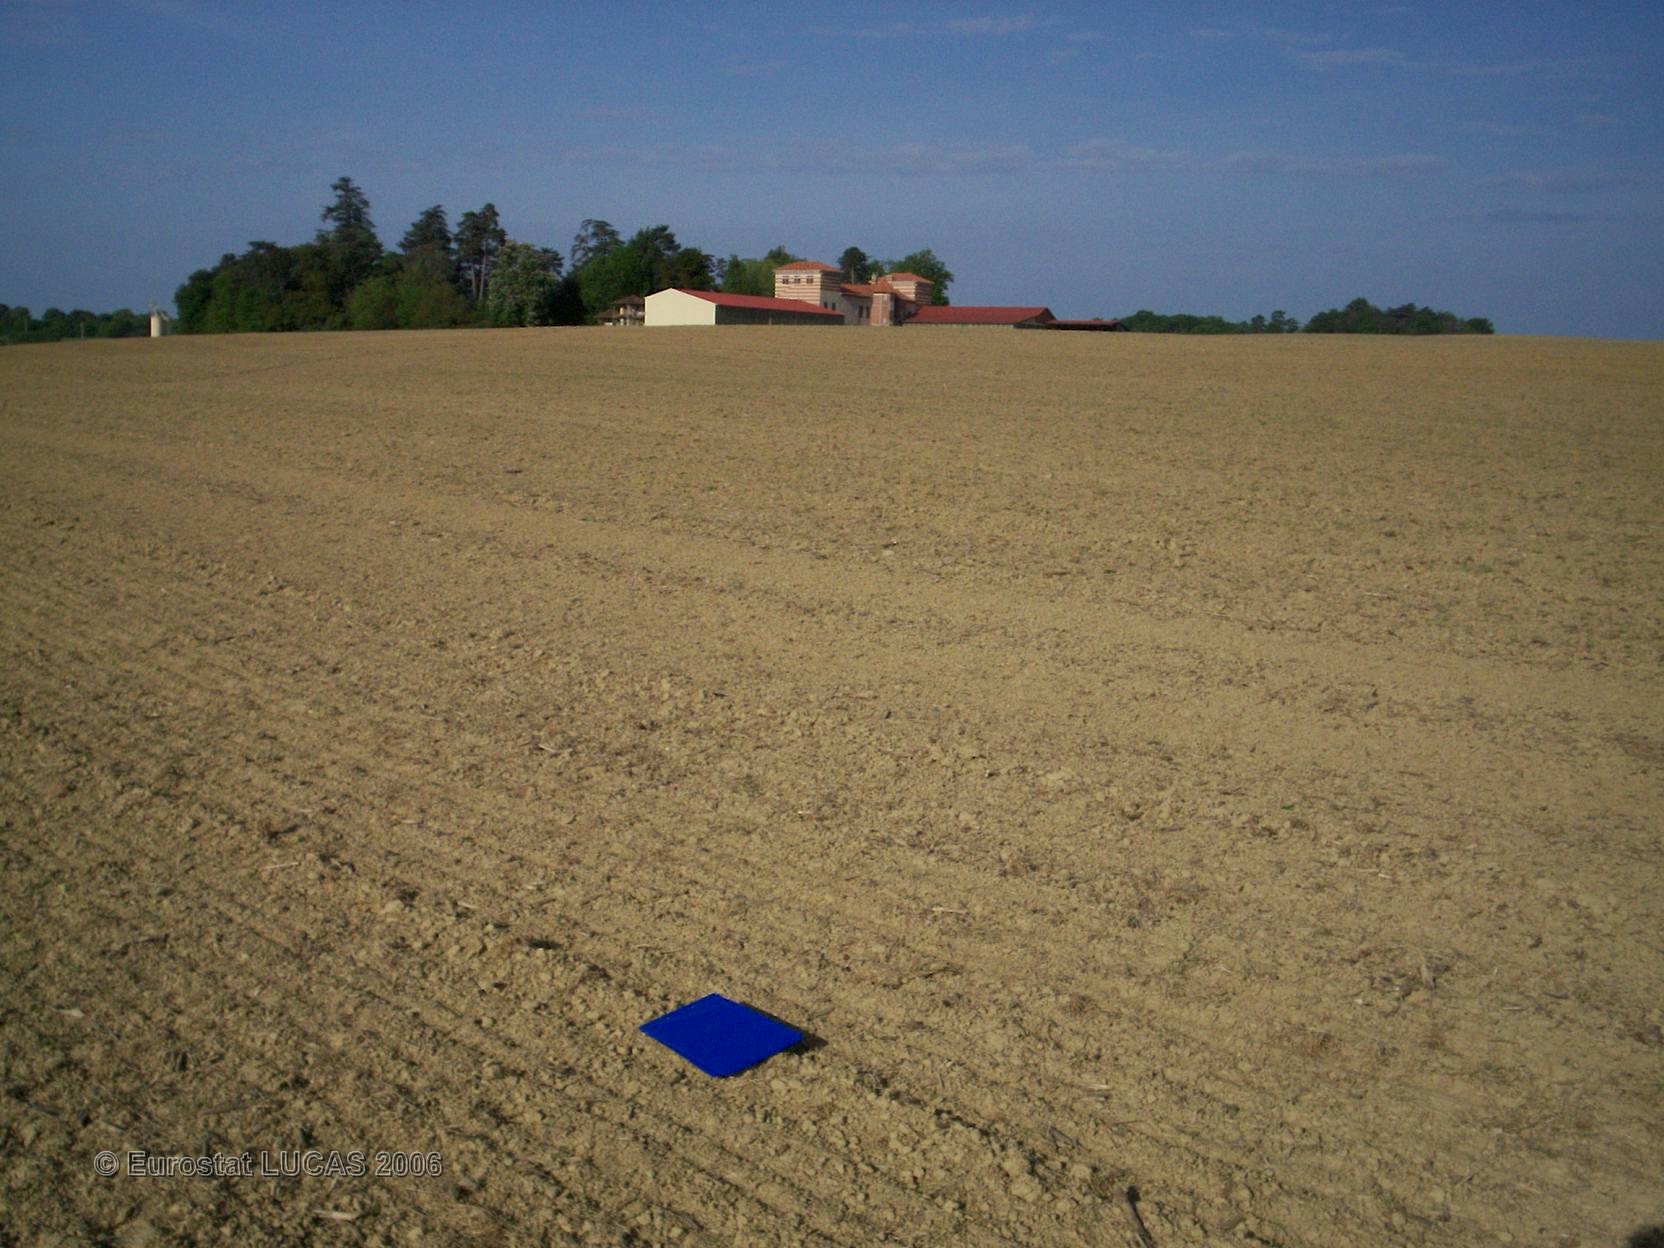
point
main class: Cropland
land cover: Maize
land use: Agriculture (excluding fallow land and kitchen gardens)
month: May
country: FR
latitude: 43.7735
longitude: 0.1670
